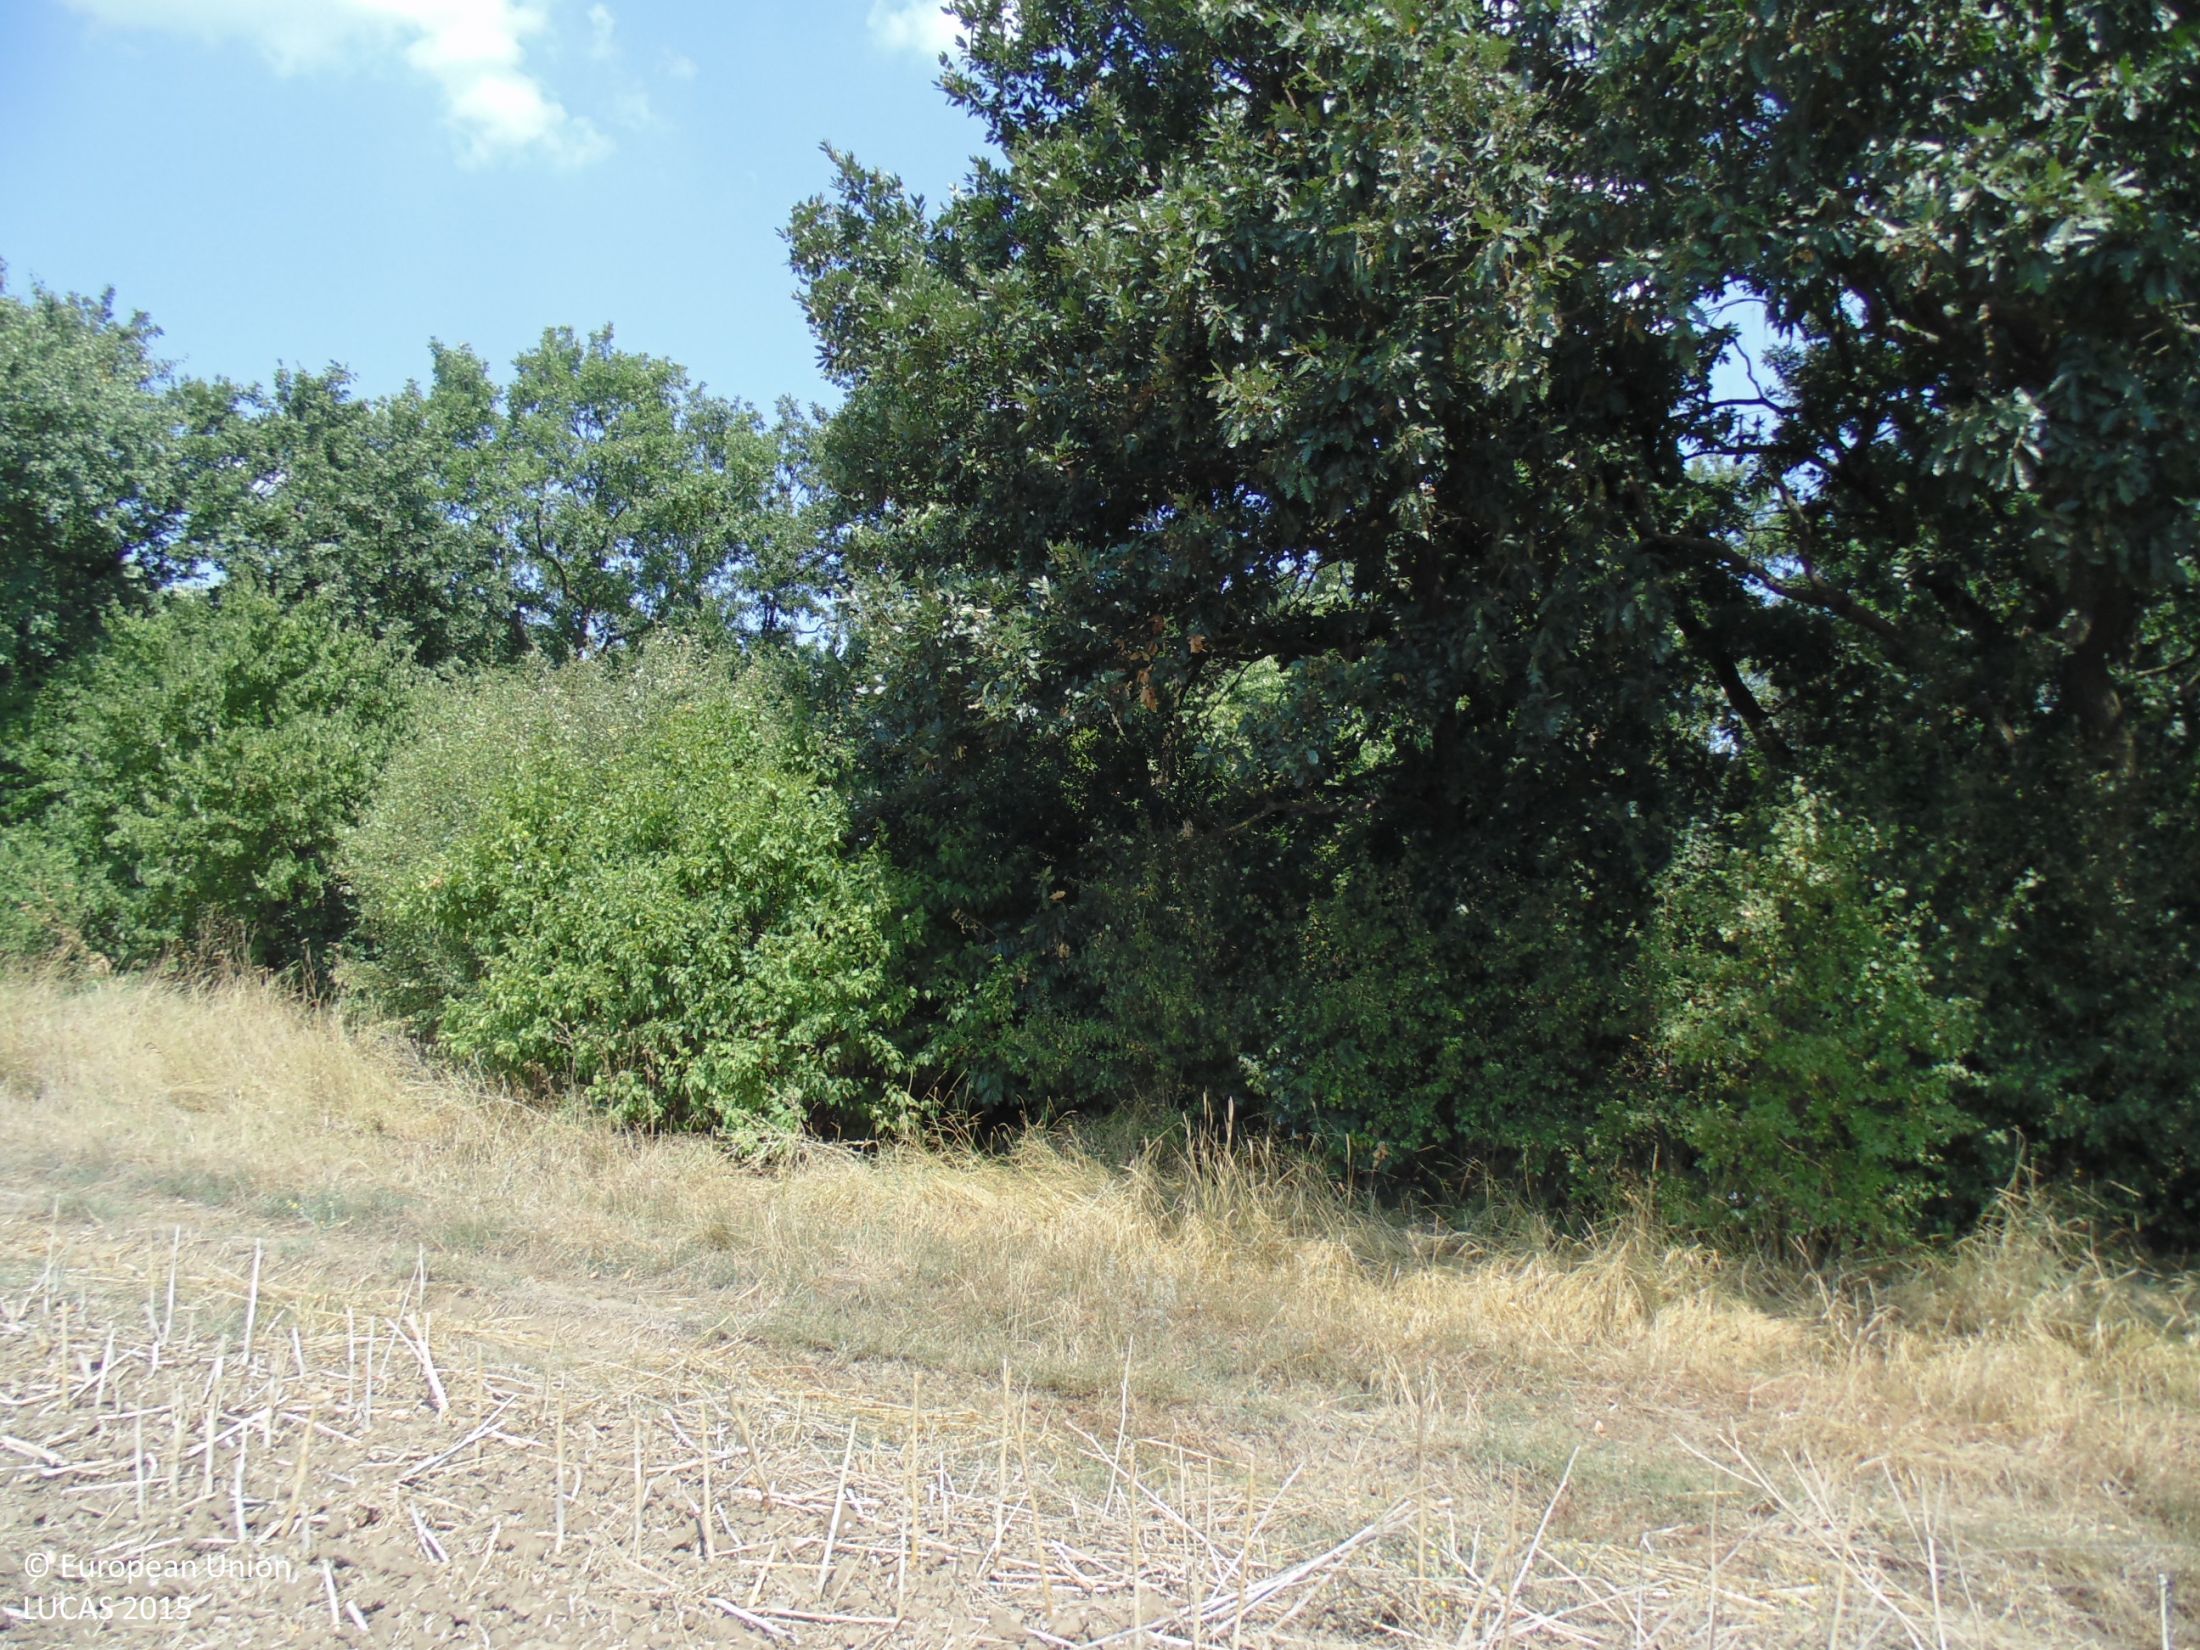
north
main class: Cropland
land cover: Rape and turnip rape
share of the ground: 10 - 25 %
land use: Agriculture (excluding fallow land and kitchen gardens)
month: August
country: BG
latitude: 43.9952
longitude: 27.5849
